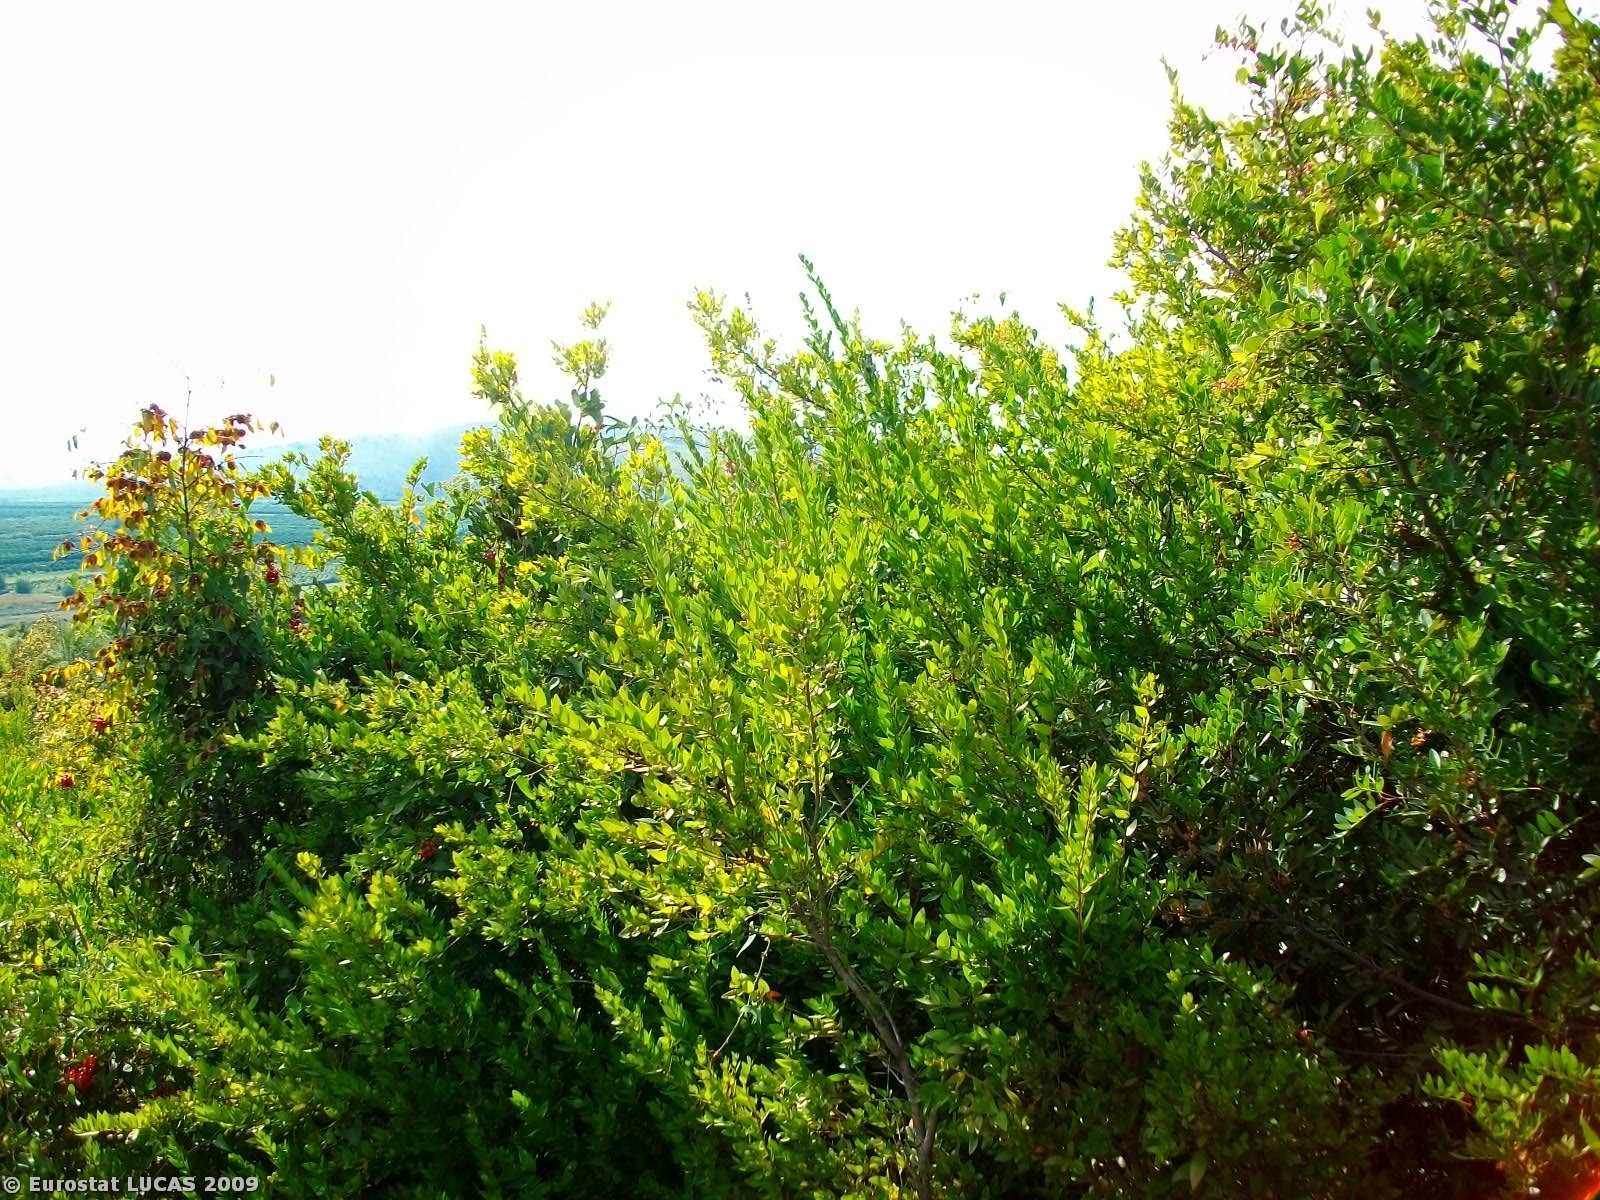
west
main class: Shrubland
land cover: Shrubland without tree cover
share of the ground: > 75 %
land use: Unused
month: September
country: GR
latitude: 39.6030
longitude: 20.2350
